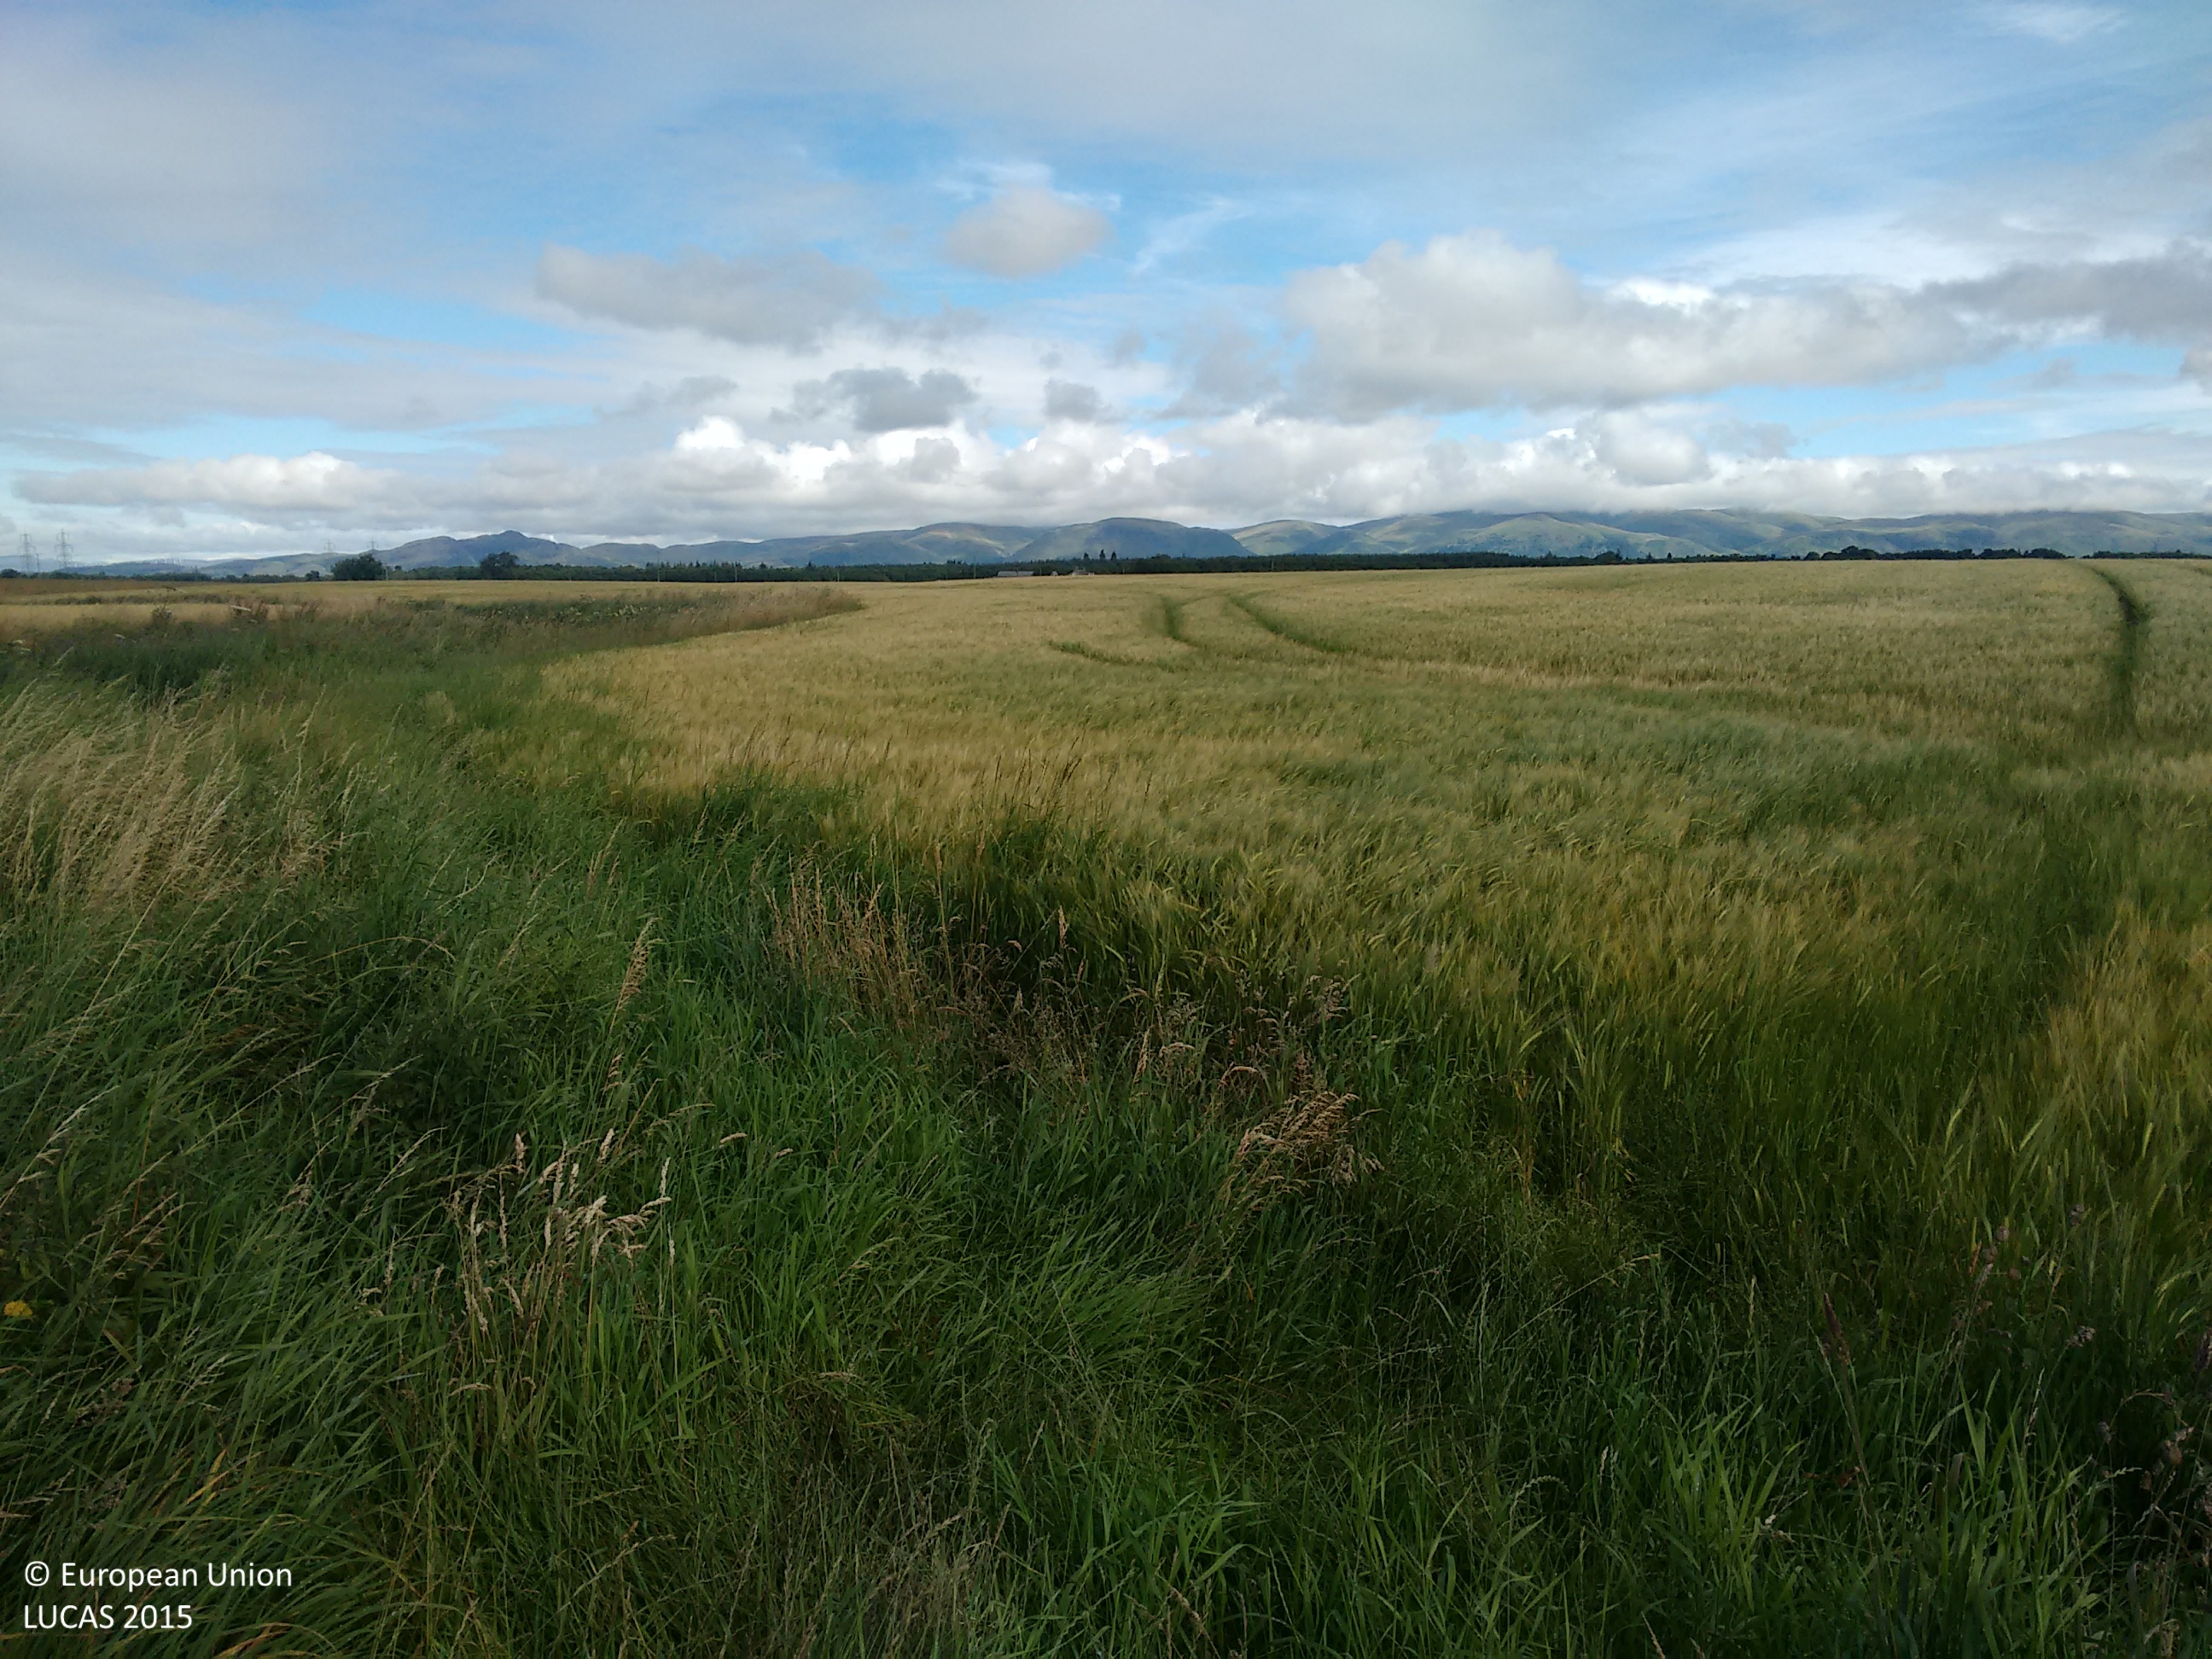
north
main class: Cropland
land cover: Barley
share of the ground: > 75 %
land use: Agriculture (excluding fallow land and kitchen gardens)
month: August
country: GB
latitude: 56.0605
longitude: -3.7816
